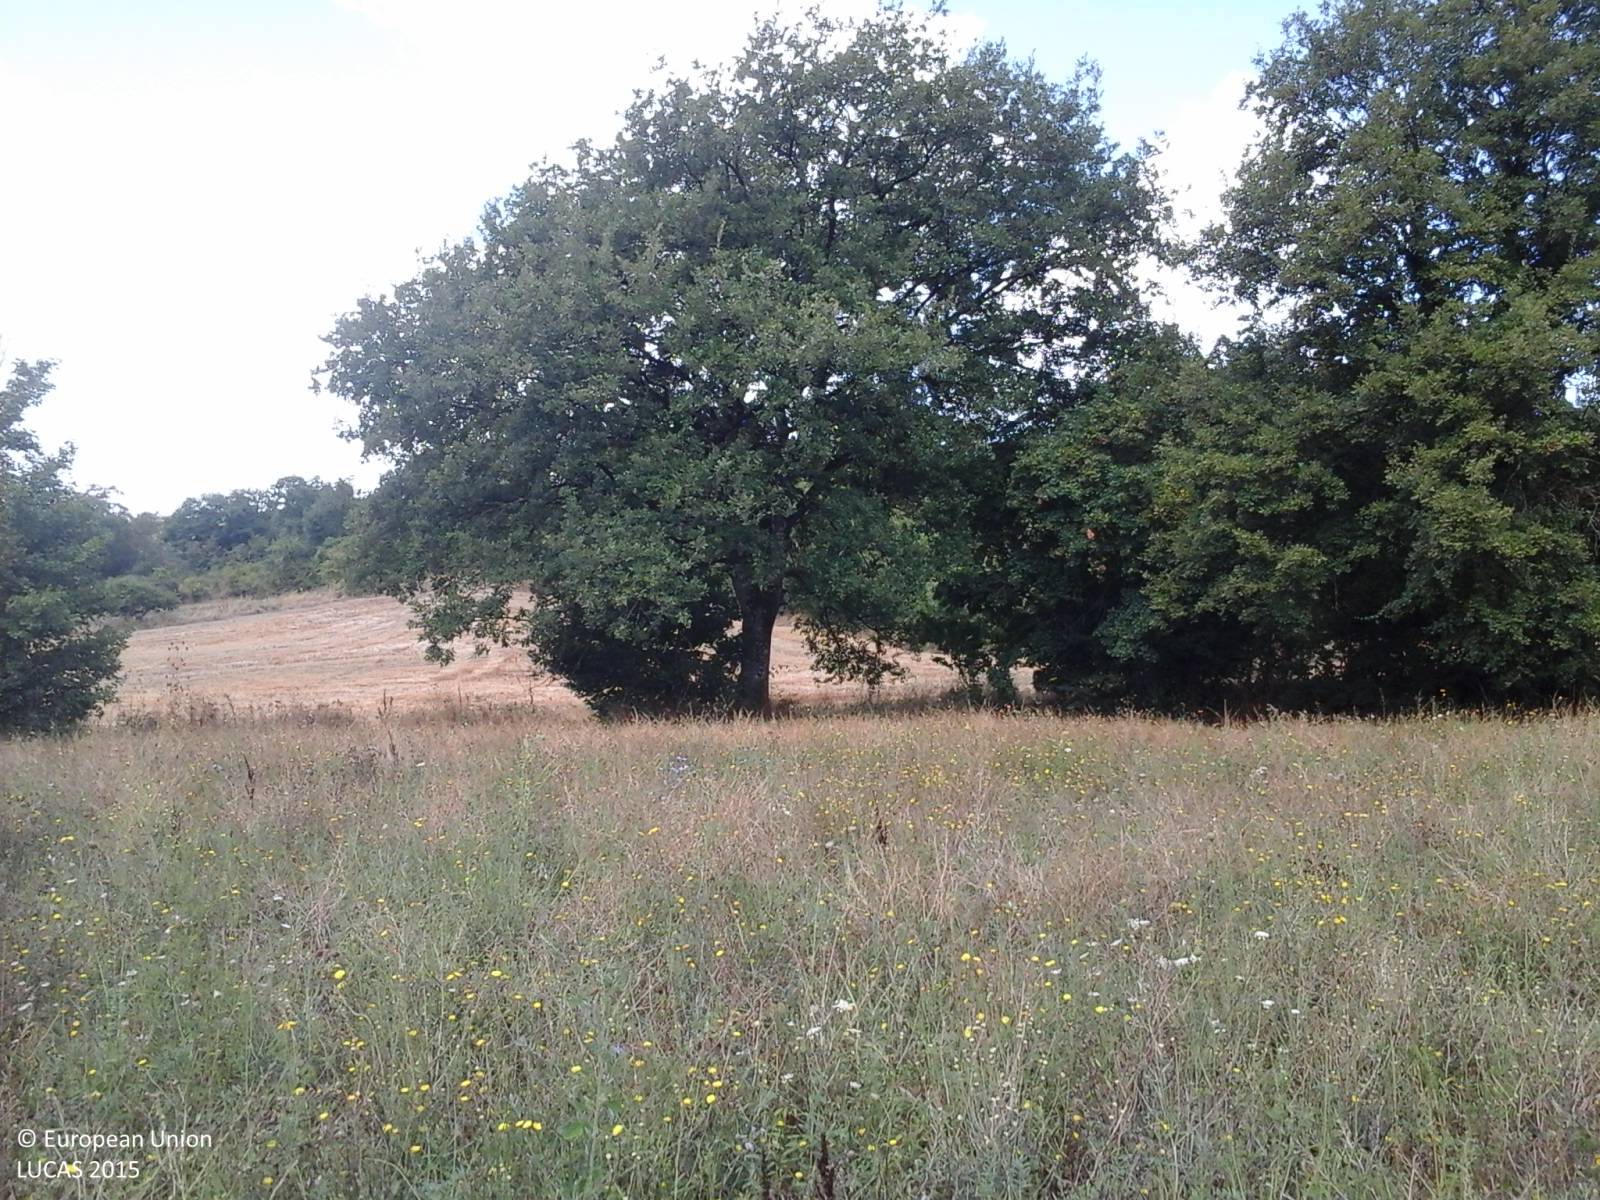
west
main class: Cropland
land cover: Temporary grasslands
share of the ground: > 75 %
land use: Agriculture (excluding fallow land and kitchen gardens)
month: August
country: IT
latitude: 43.4629
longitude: 12.1078
